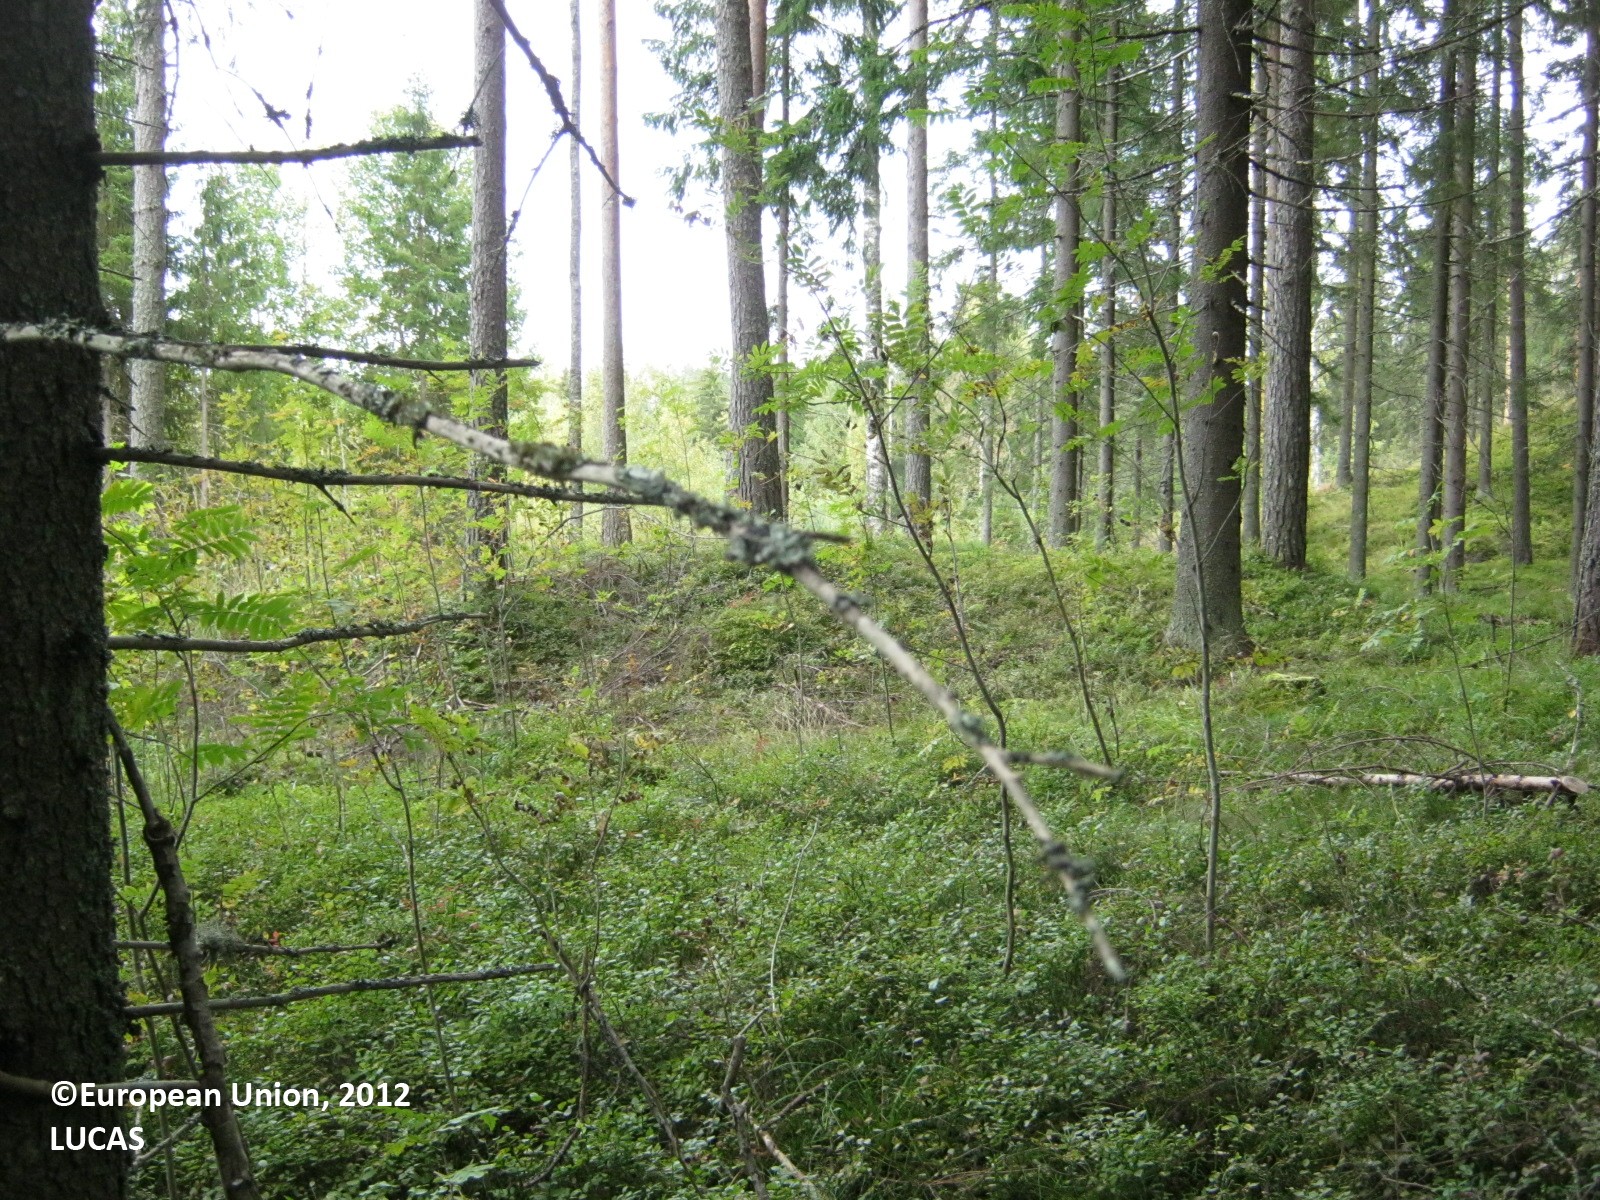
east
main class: Woodland
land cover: Spruce dominated coniferous woodland
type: boreal forest
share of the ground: > 75 %
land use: Forestry
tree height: > 5 m
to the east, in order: Spruce dominated coniferous woodland; Tracks; Spruce dominated coniferous woodland; Ditches and canals; Grass margins; Tracks; Grass margins; Ditches and canals; Broadleaved woodland; Ditches and canals; Grass margins; Tracks; Grass margins; Ditches and canals; Spruce dominated coniferous woodland; Ditches and canals; Broadleaved woodland
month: September
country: FI
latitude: 60.7712
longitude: 27.8385
